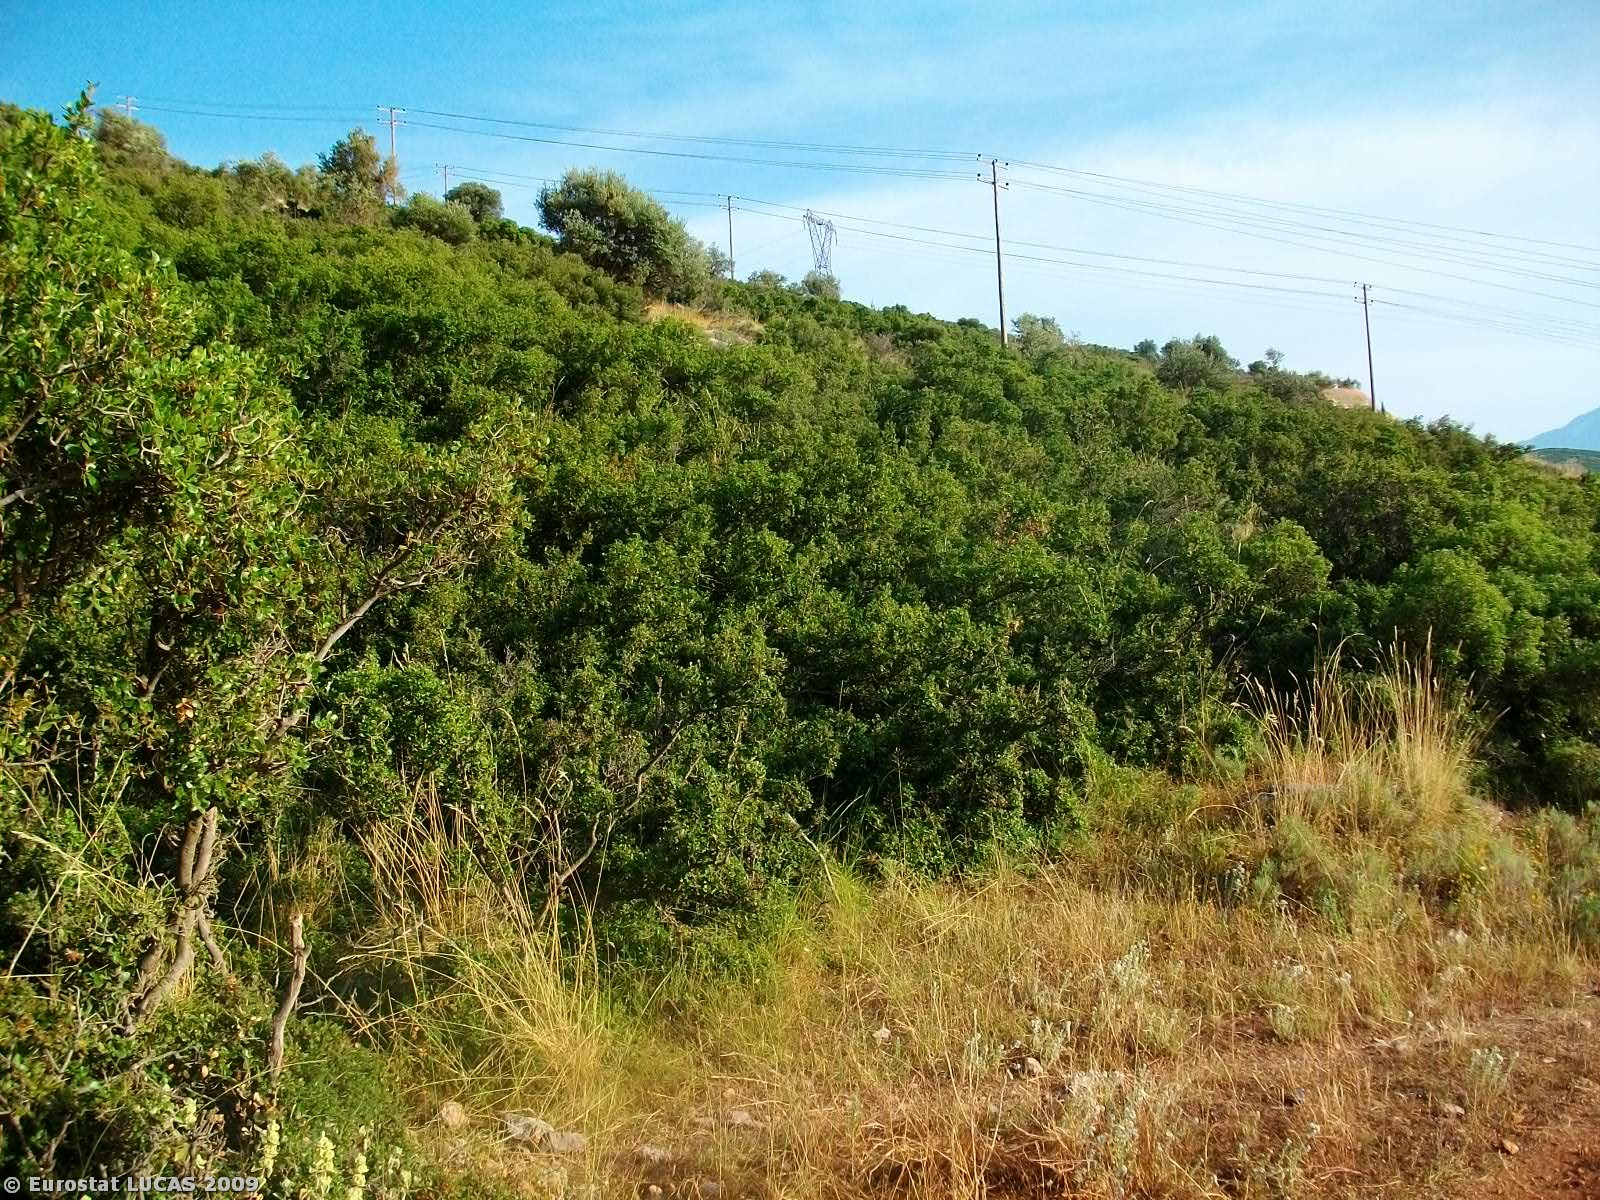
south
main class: Shrubland
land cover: Shrubland with sparse tree cover
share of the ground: 25 - 50 %
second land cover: Olive groves
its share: 25 - 50 %
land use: Unused
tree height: < 5 m
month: June
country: GR
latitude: 38.9223
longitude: 22.4495
